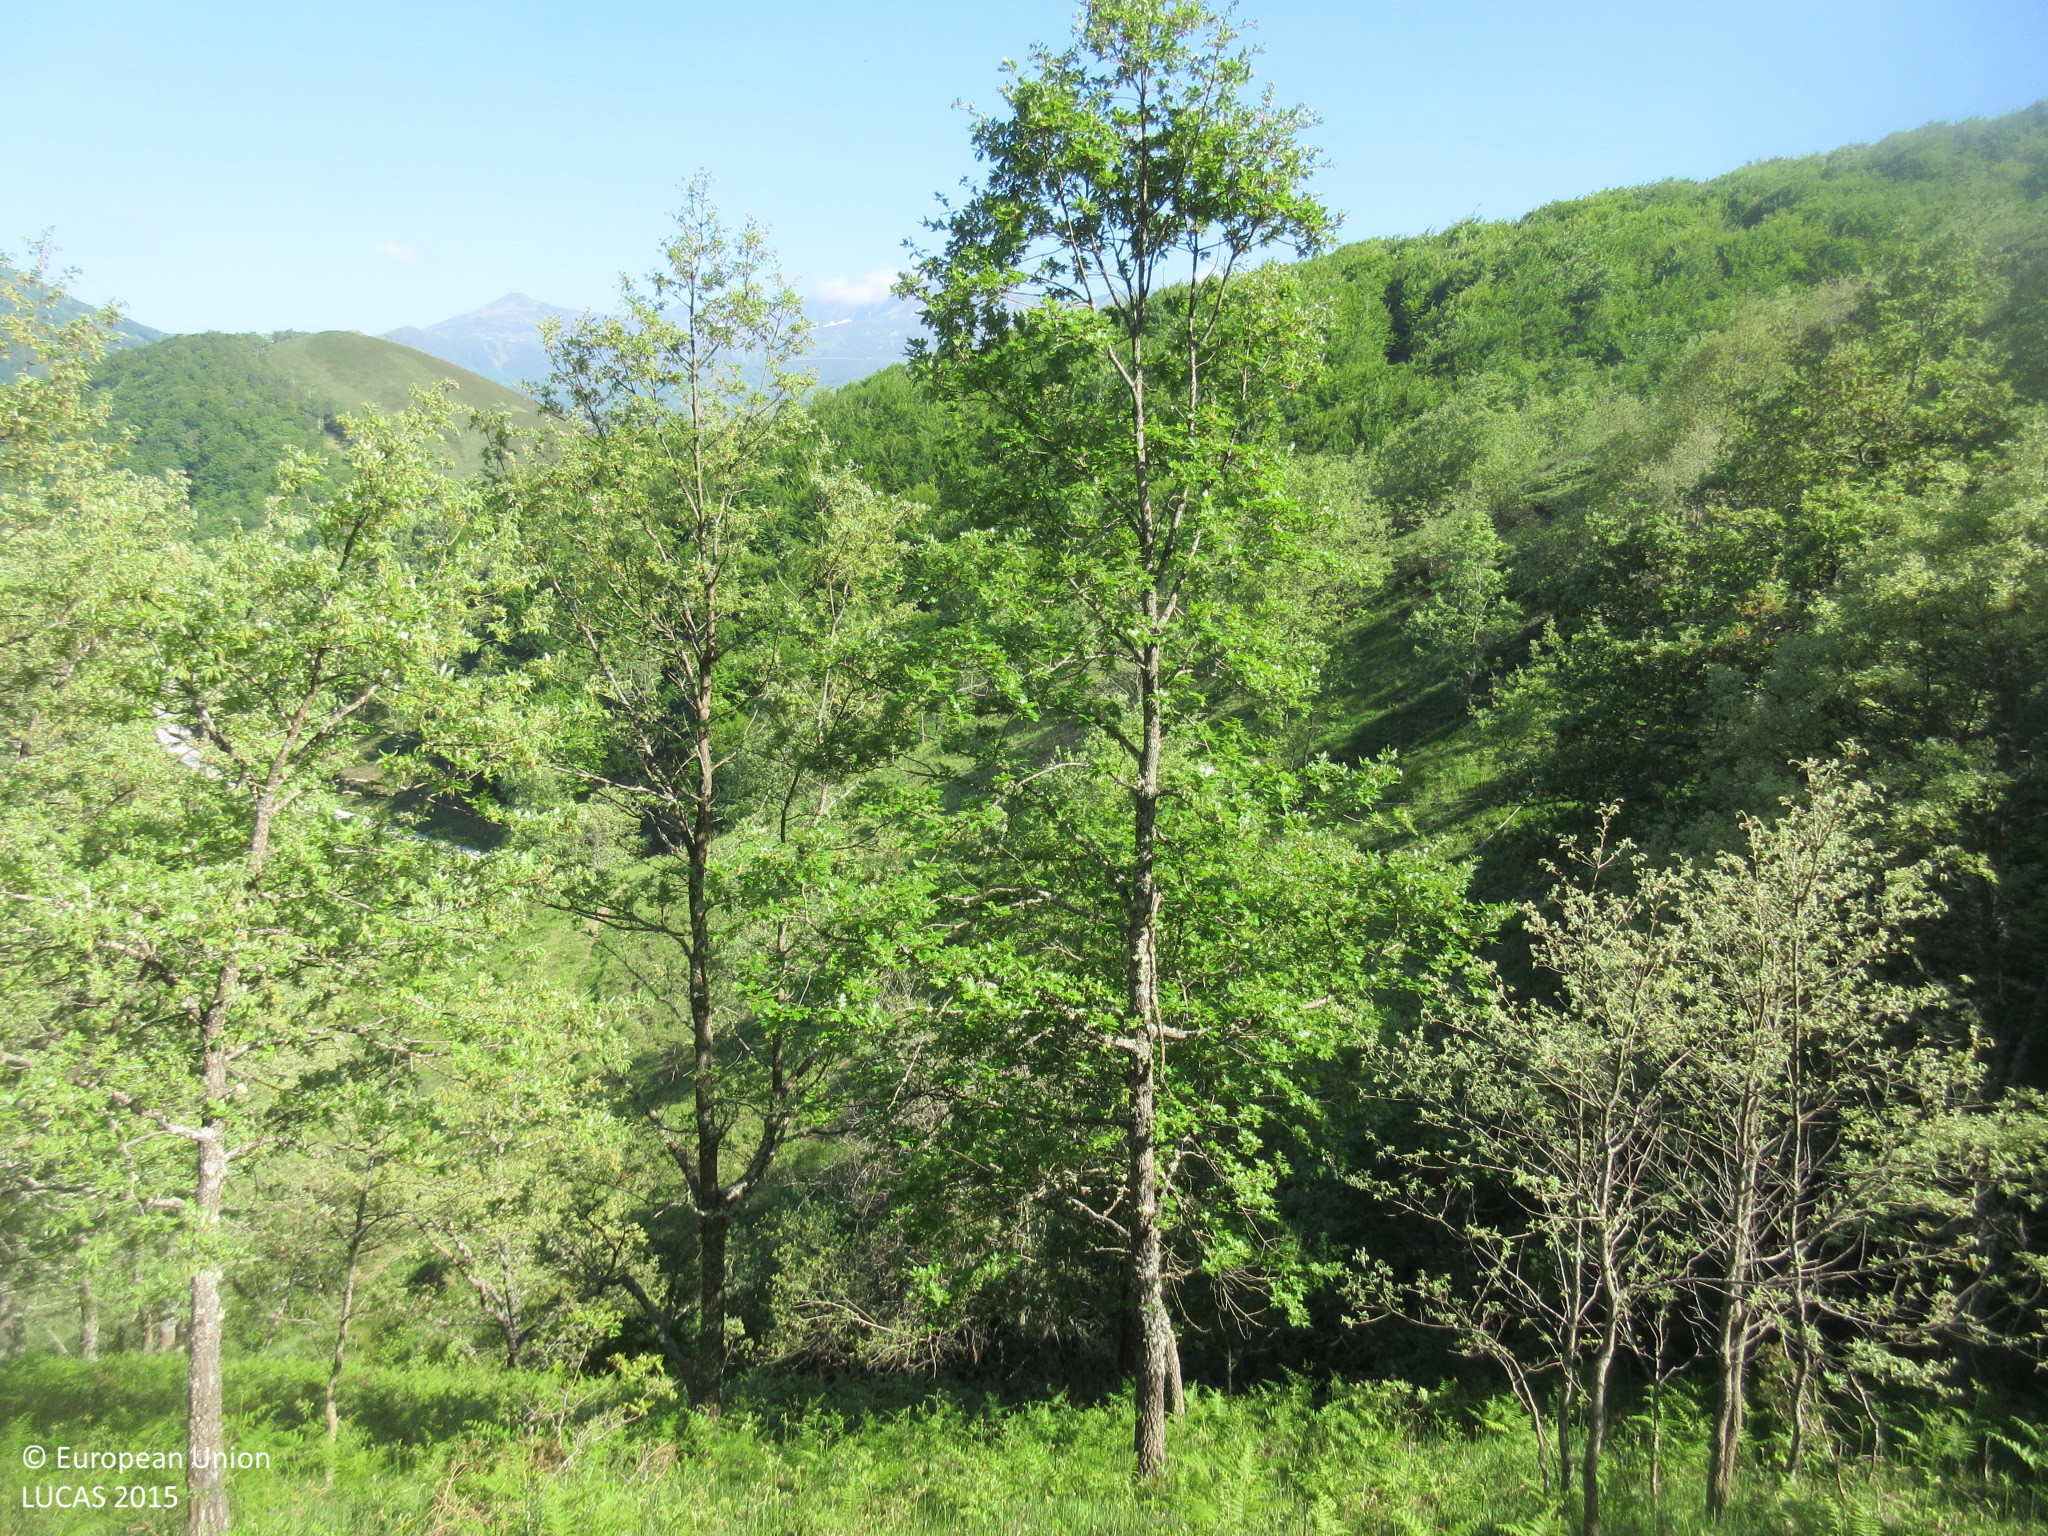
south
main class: Woodland
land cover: Broadleaved woodland
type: acidophilous oak and oak-birch forest
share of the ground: 50 - 75 %
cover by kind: broadleaved forest trees 60 %, shrubs 30 %, herbaceous plants 10 %
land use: Agriculture (excluding fallow land and kitchen gardens)
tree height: > 5 m
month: June
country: ES
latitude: 43.0994
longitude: -4.4190
